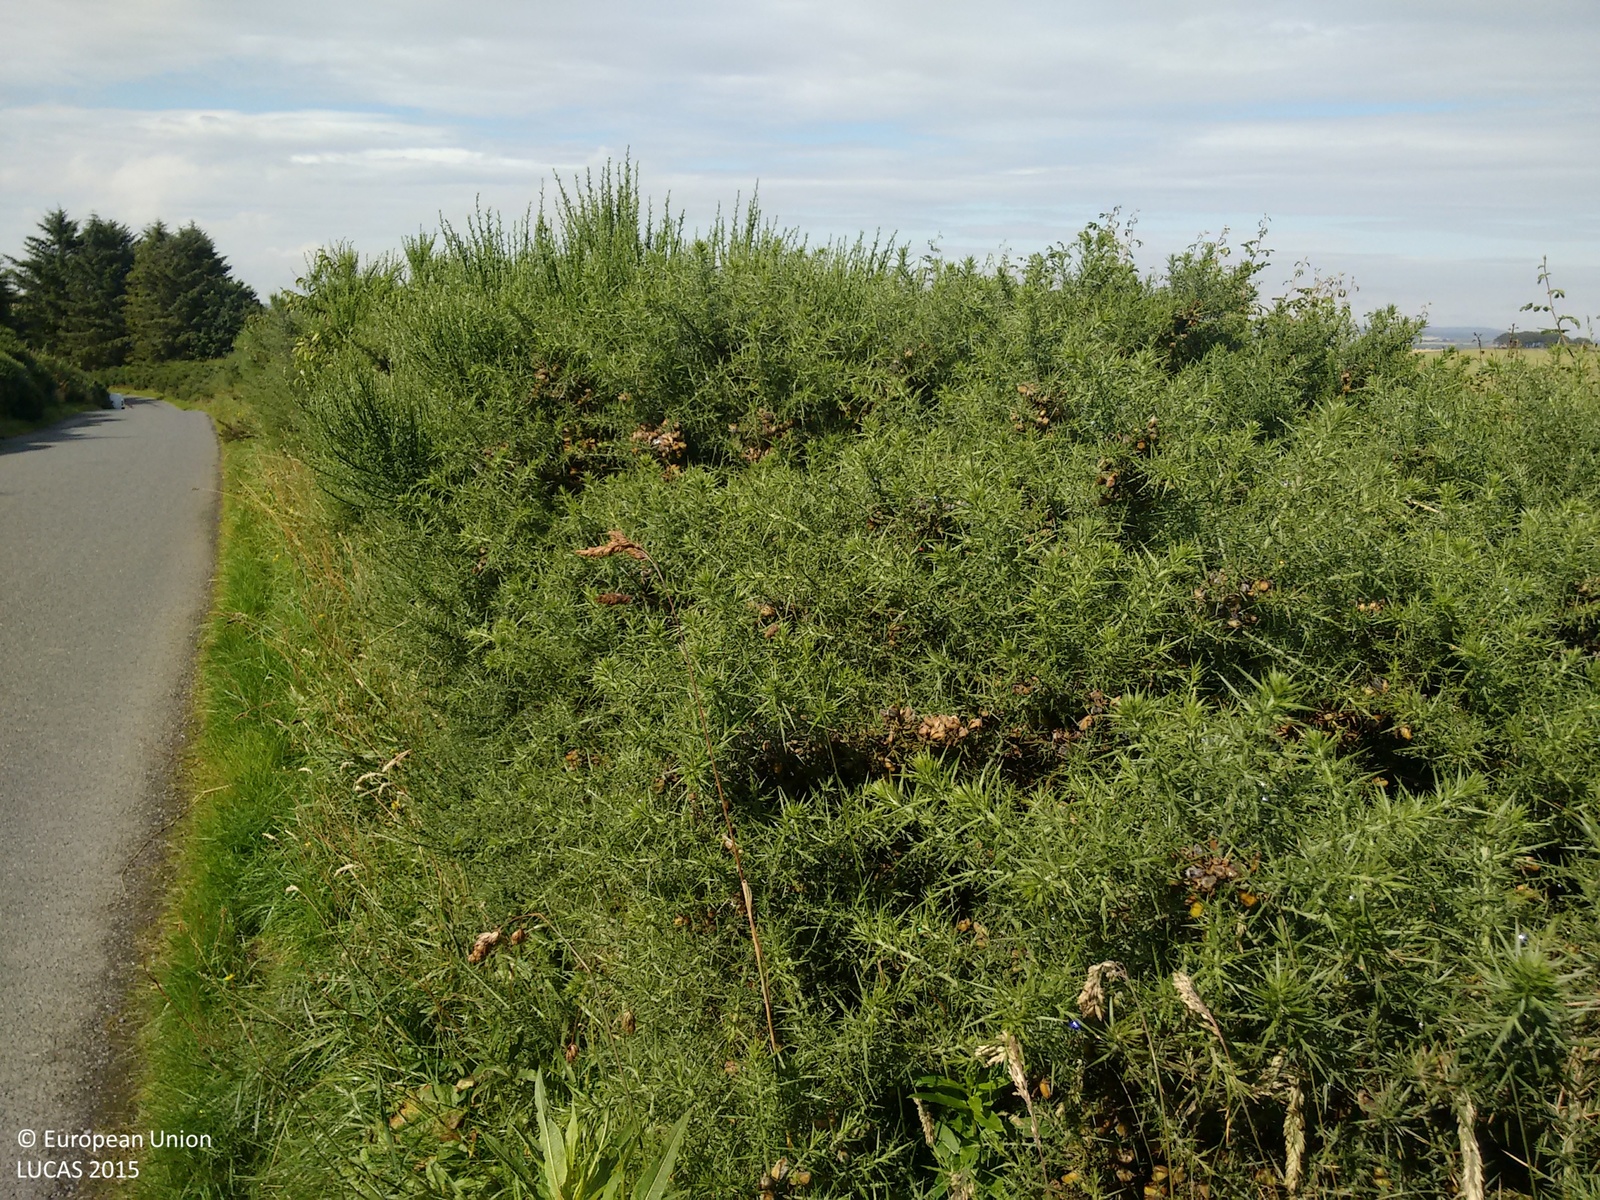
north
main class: Shrubland
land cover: Shrubland without tree cover
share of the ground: > 75 %
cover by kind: shrubs 100 %
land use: Agriculture (excluding fallow land and kitchen gardens)
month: August
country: GB
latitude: 57.4638
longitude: -2.1673
